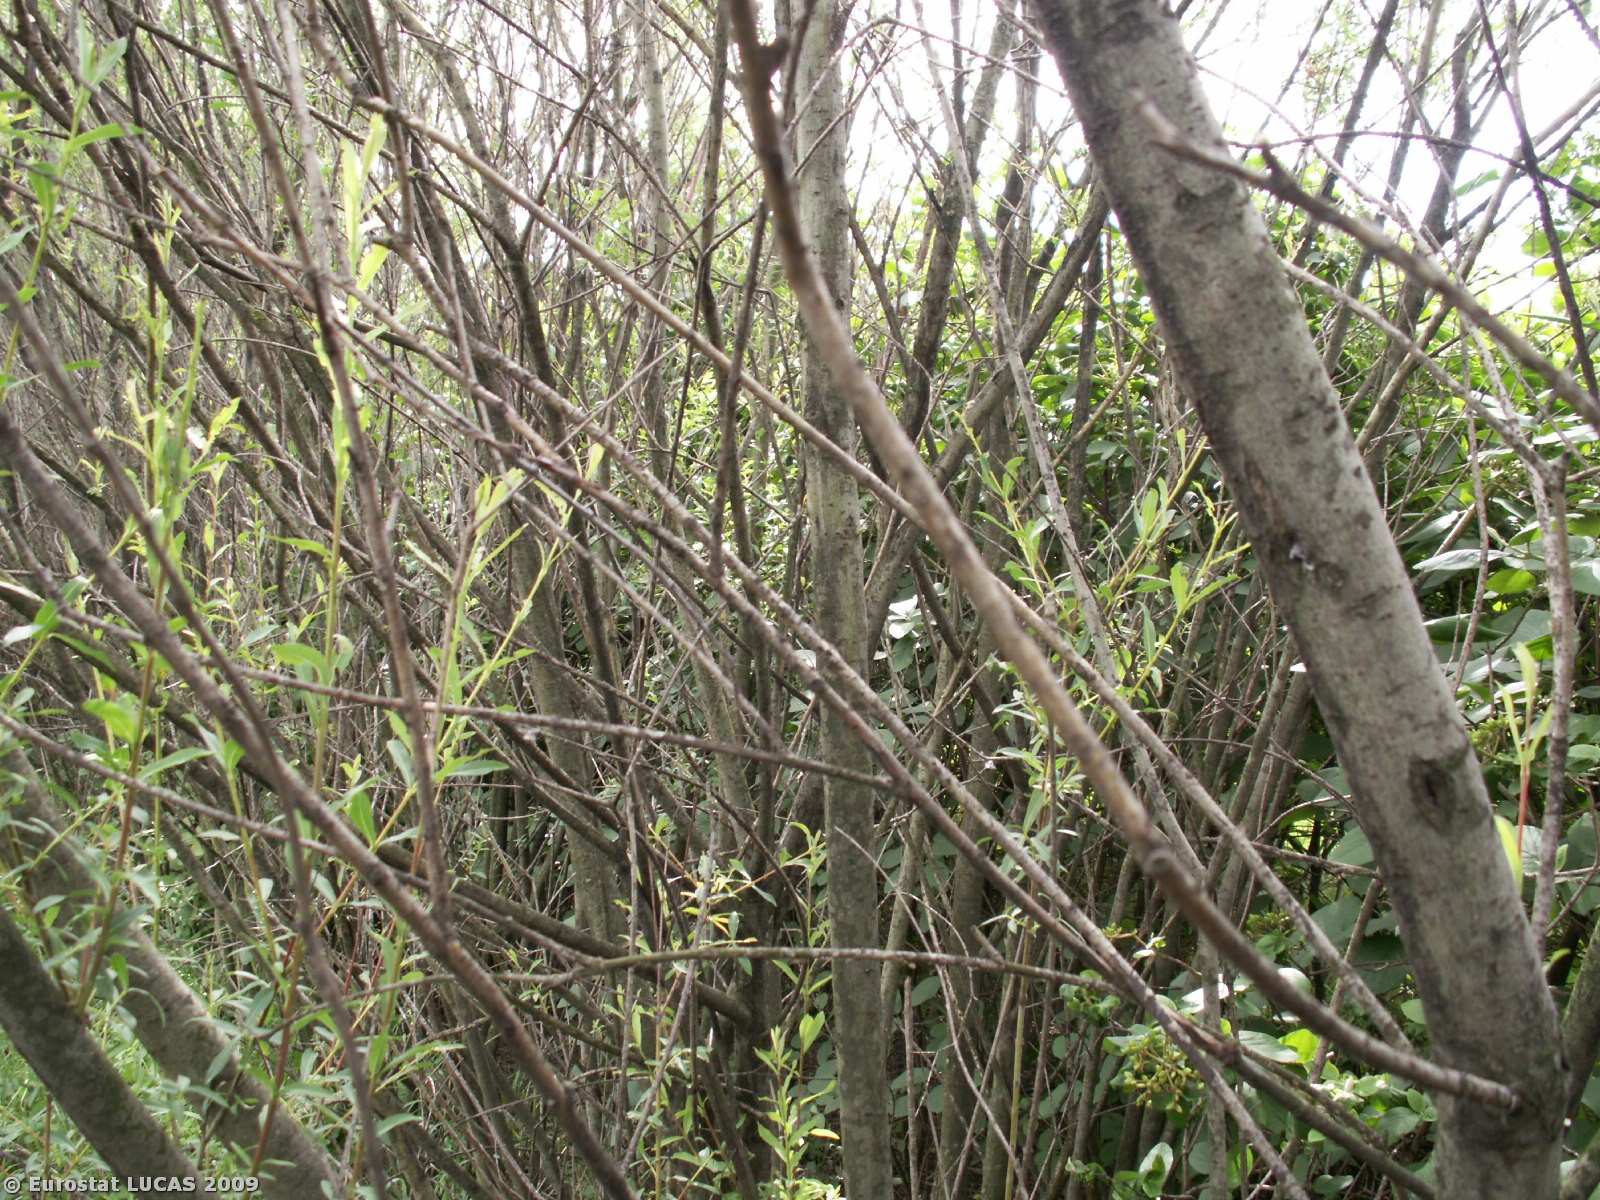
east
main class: Woodland
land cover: Broadleaved woodland
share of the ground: > 75 %
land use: Unused
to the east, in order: Broadleaved woodland; Grassland without tree/shrub cover; Paved roads, cycling and walking lanes; Grass margins; Paved roads, cycling and walking lanes; Grassland without tree/shrub cover; Shrubland with sparse tree cover; Grassland without tree/shrub cover; Shrubland with sparse tree cover; Grassland without tree/shrub cover; Paved roads, cycling and walking lanes; Grass margins; Shrubland without tree cover; Grass margins; Common wheat
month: June
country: CZ
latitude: 48.9689
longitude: 16.5227
